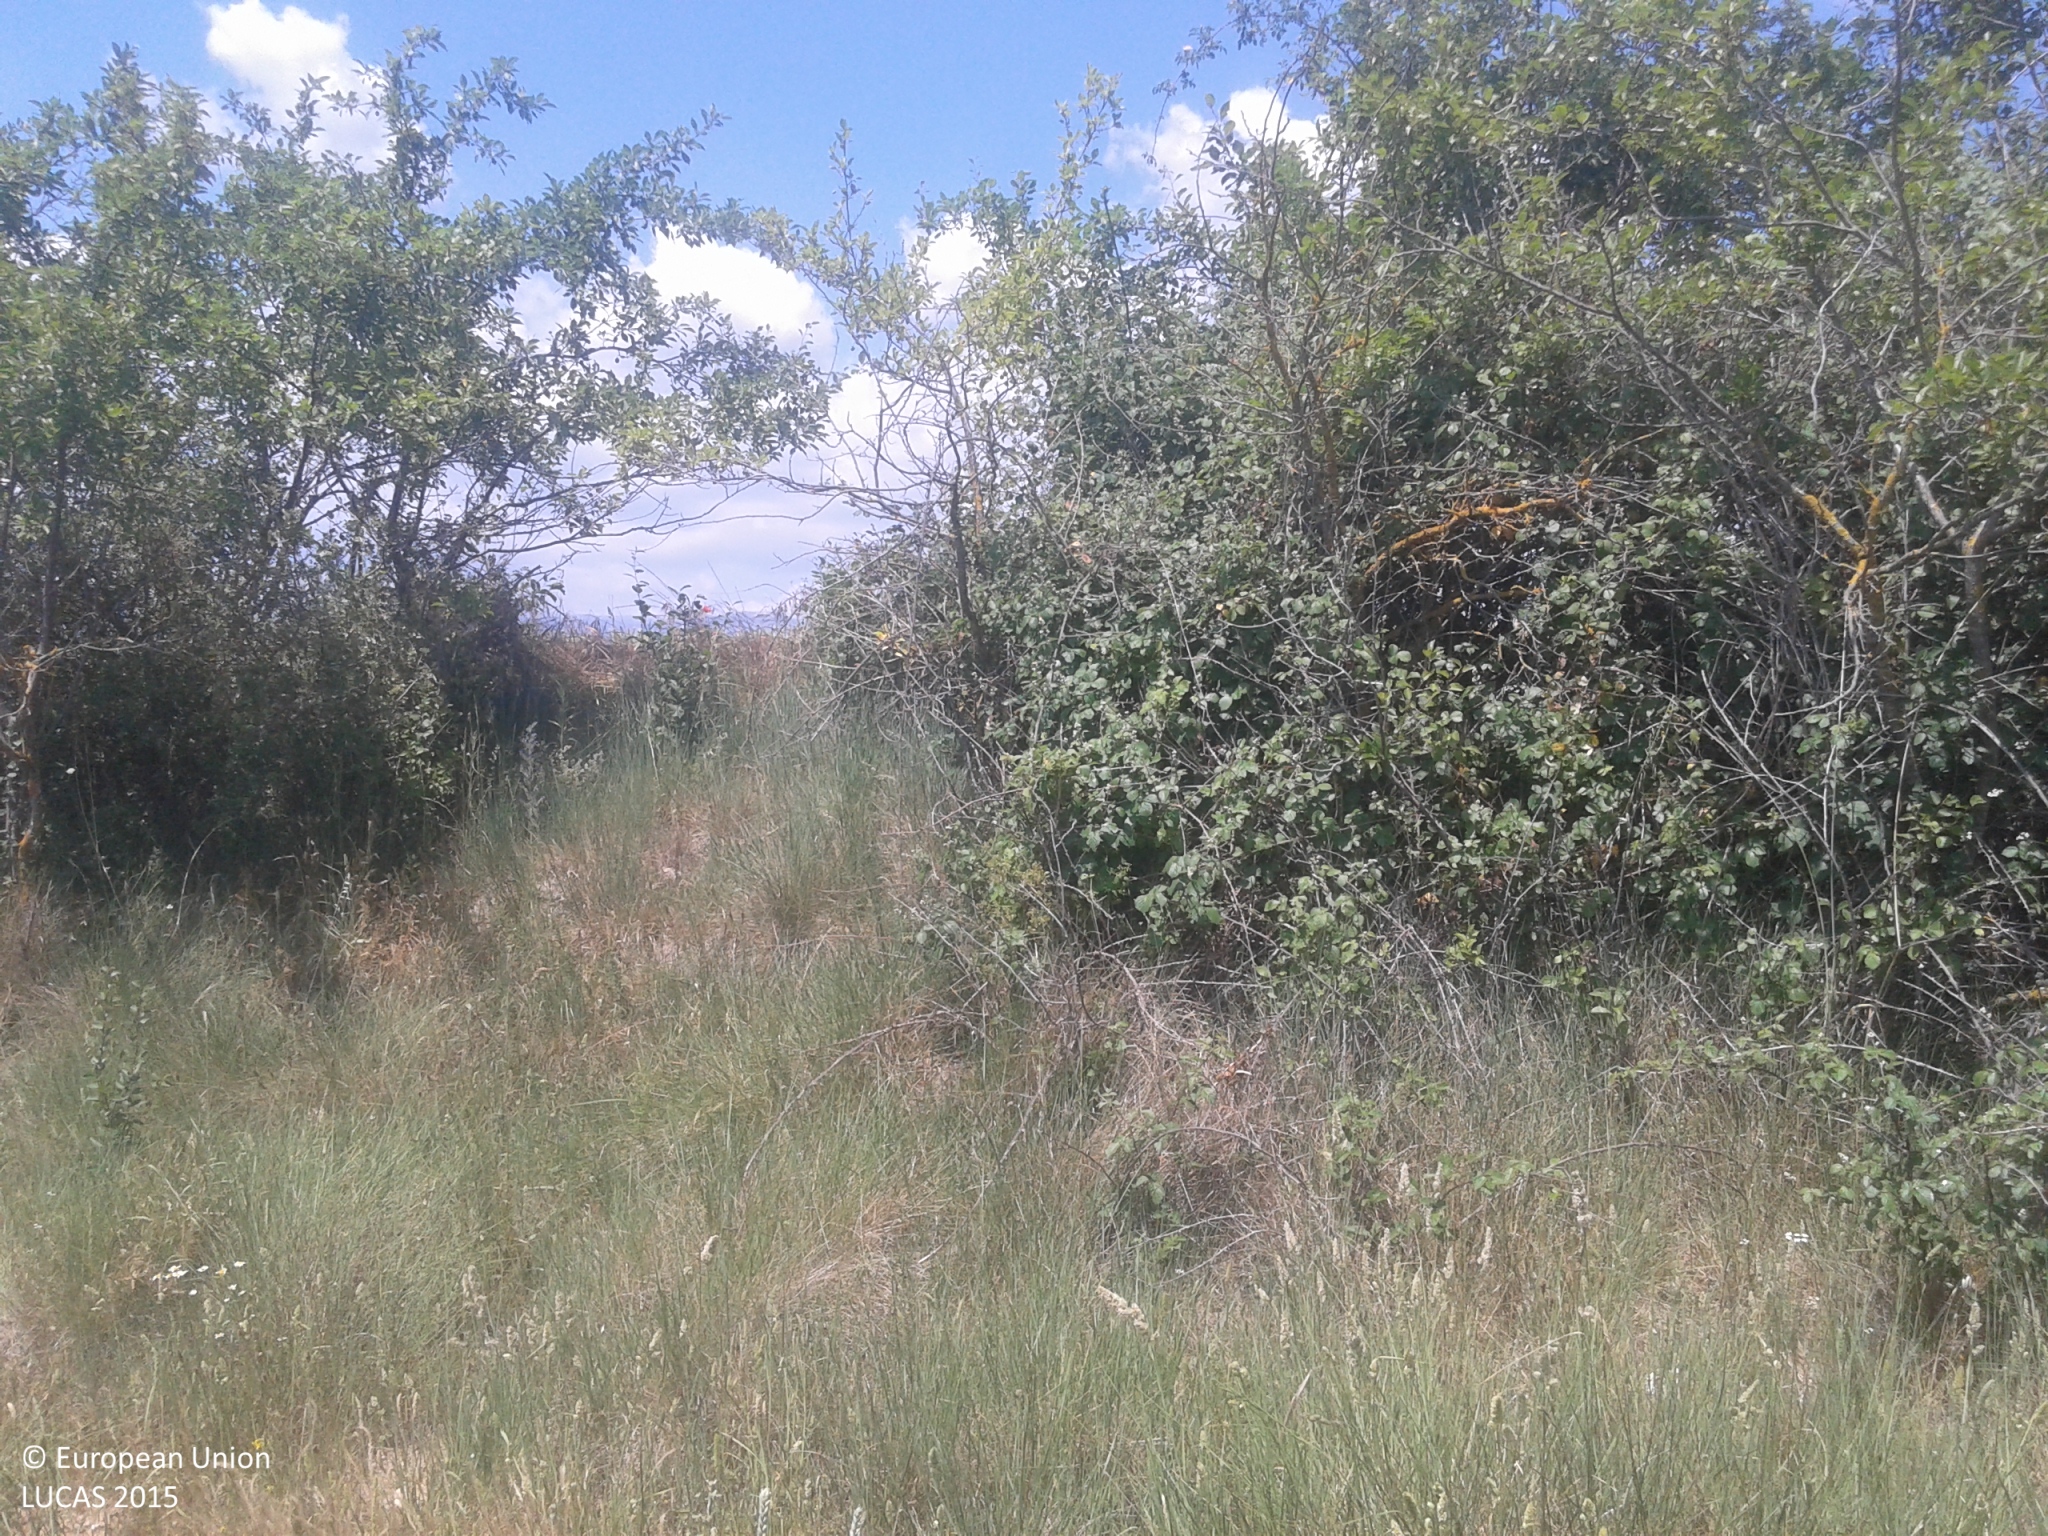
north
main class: Cropland
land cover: Common wheat
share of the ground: > 75 %
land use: Agriculture (excluding fallow land and kitchen gardens)
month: June
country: ES
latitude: 41.9739
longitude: 1.5532
